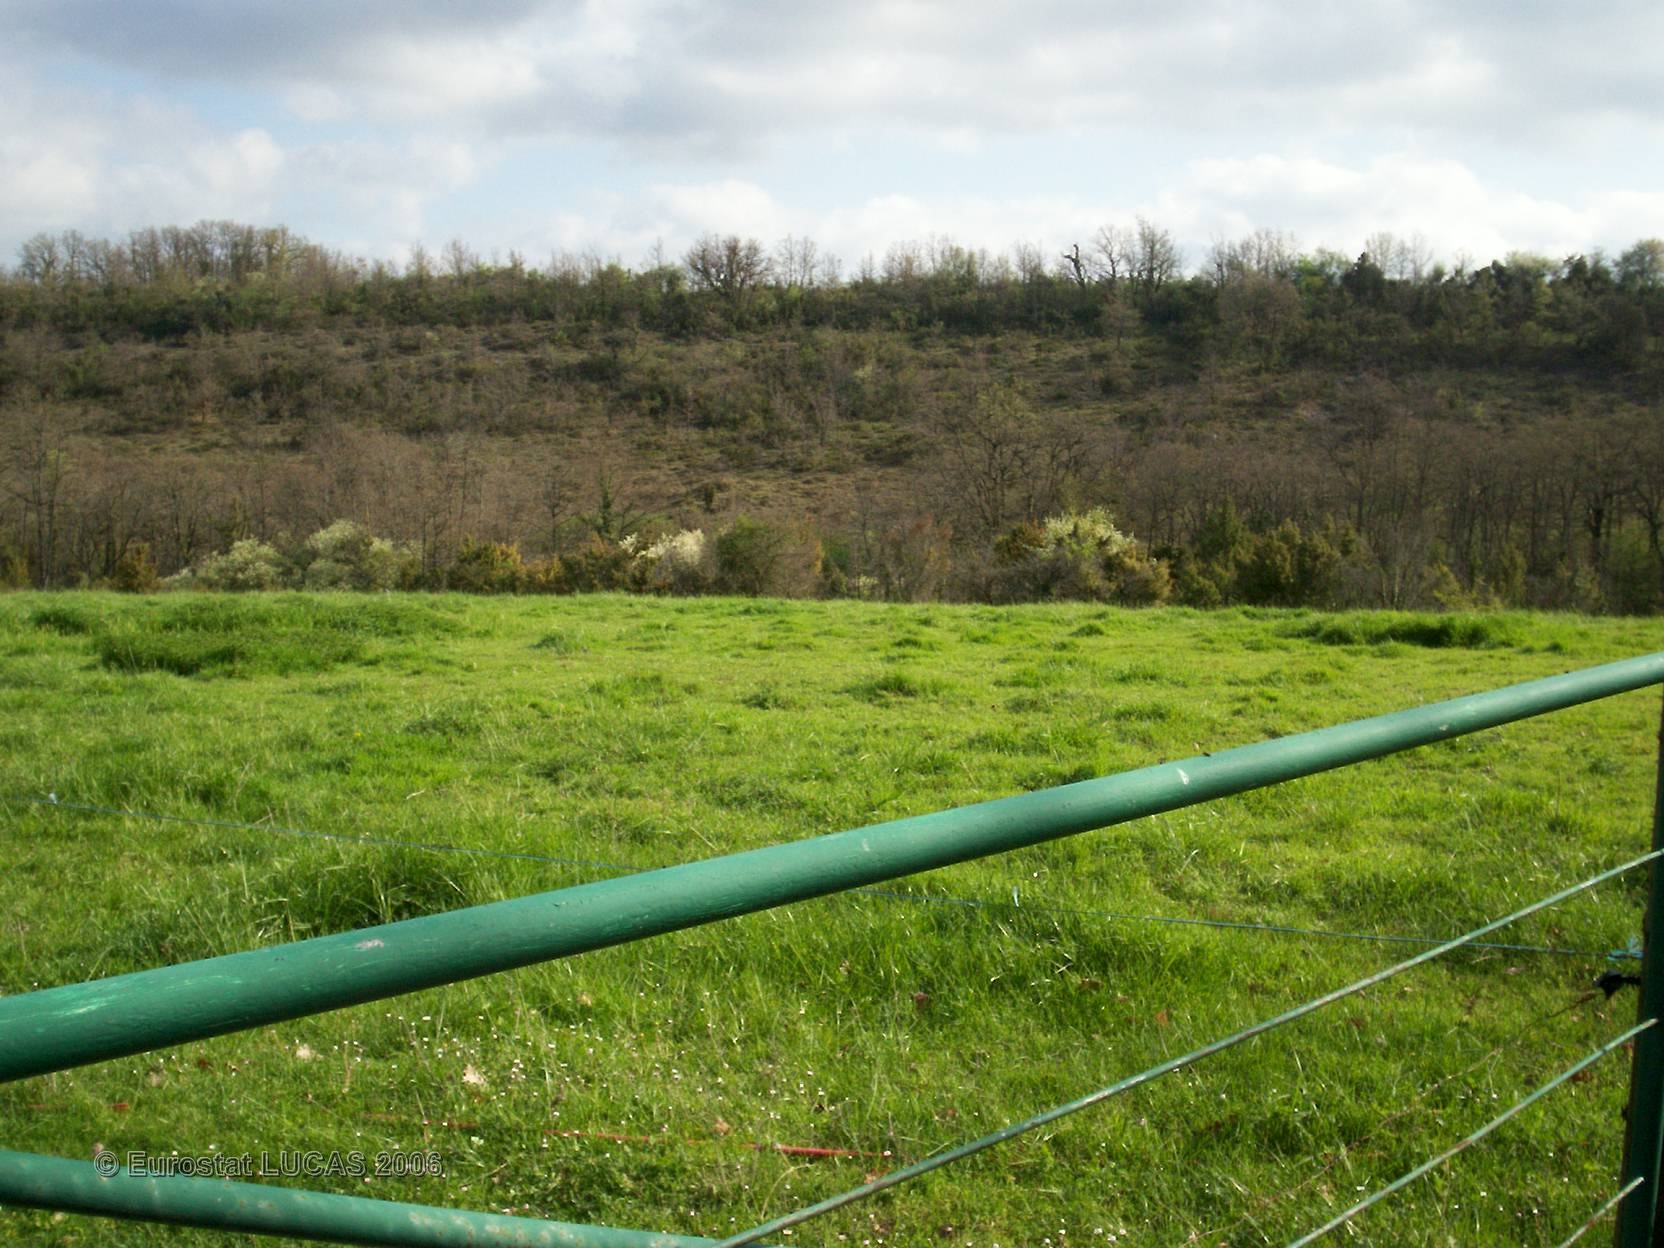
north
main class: Grassland
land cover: Grassland with sparse tree/shrub cover
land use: Agriculture (excluding fallow land and kitchen gardens)
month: April
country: FR
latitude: 44.0397
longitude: 1.9785
